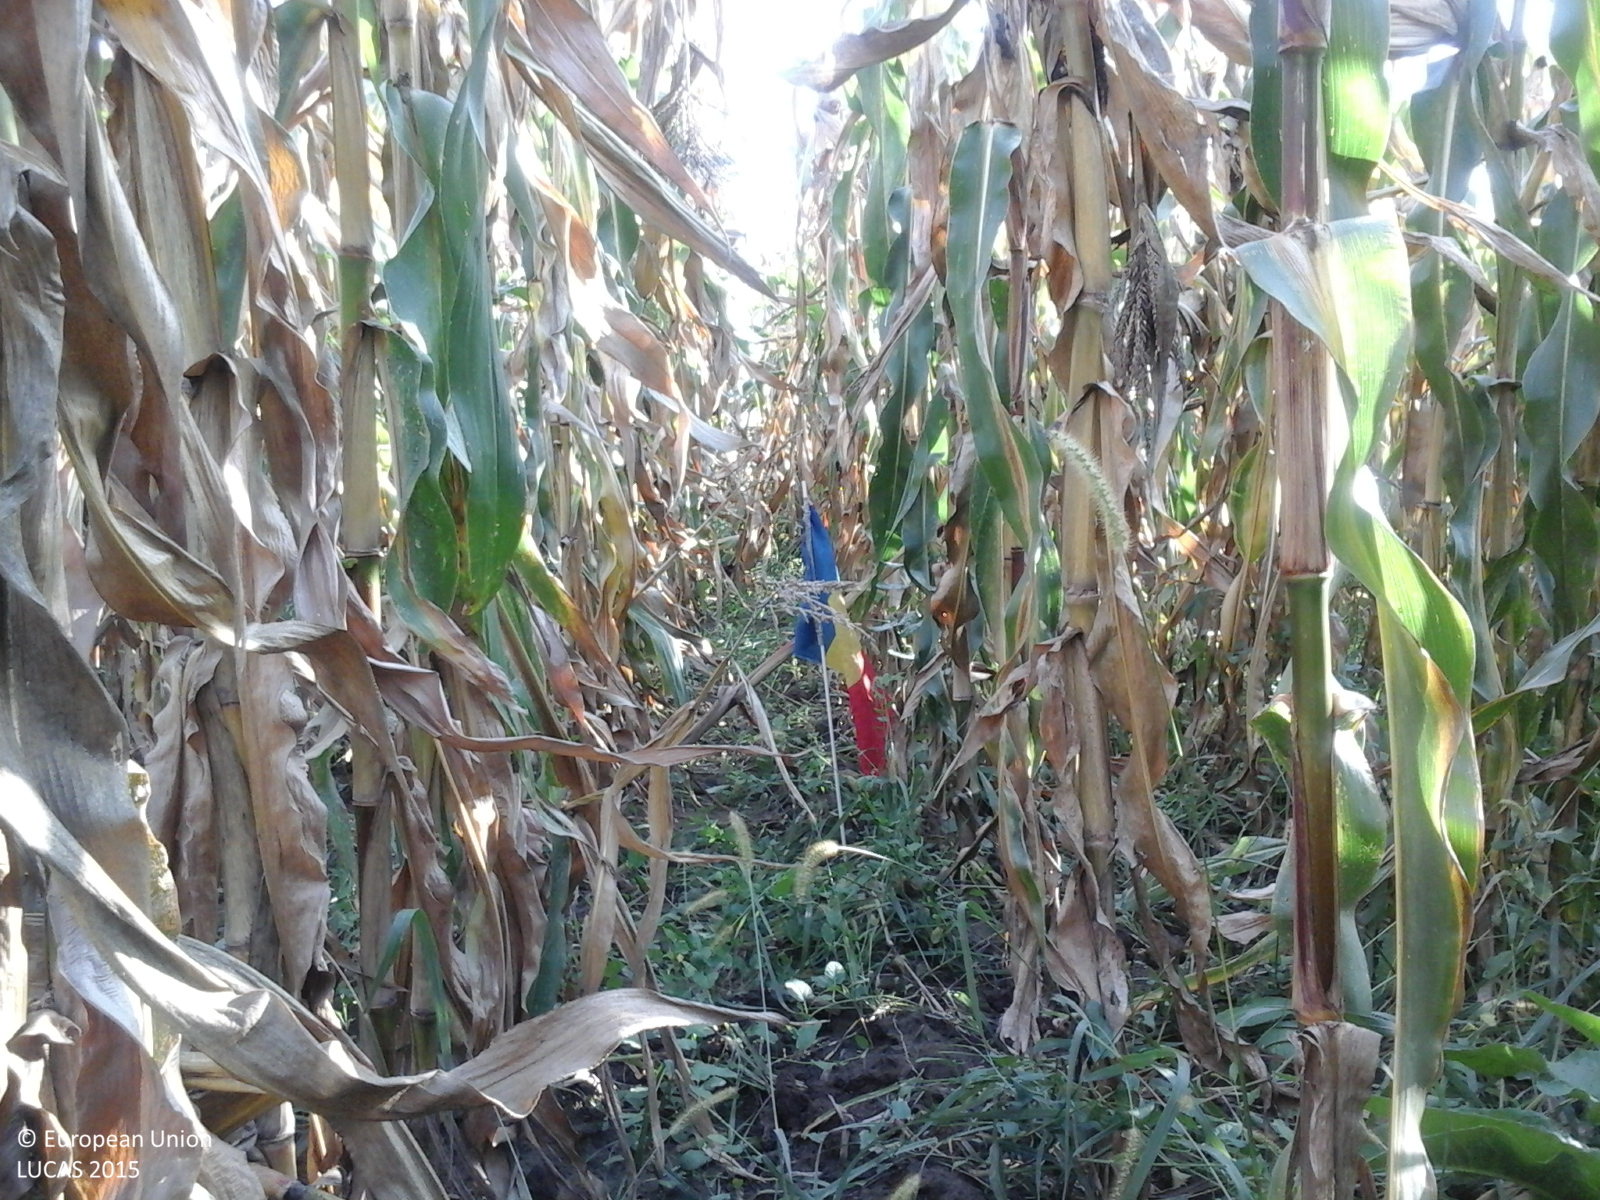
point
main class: Cropland
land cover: Maize
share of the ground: > 75 %
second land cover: Spontaneously vegetated surfaces
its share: 25 - 50 %
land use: Agriculture (excluding fallow land and kitchen gardens)
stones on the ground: < 10 %
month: September
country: RO
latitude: 46.7580
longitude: 23.4354
